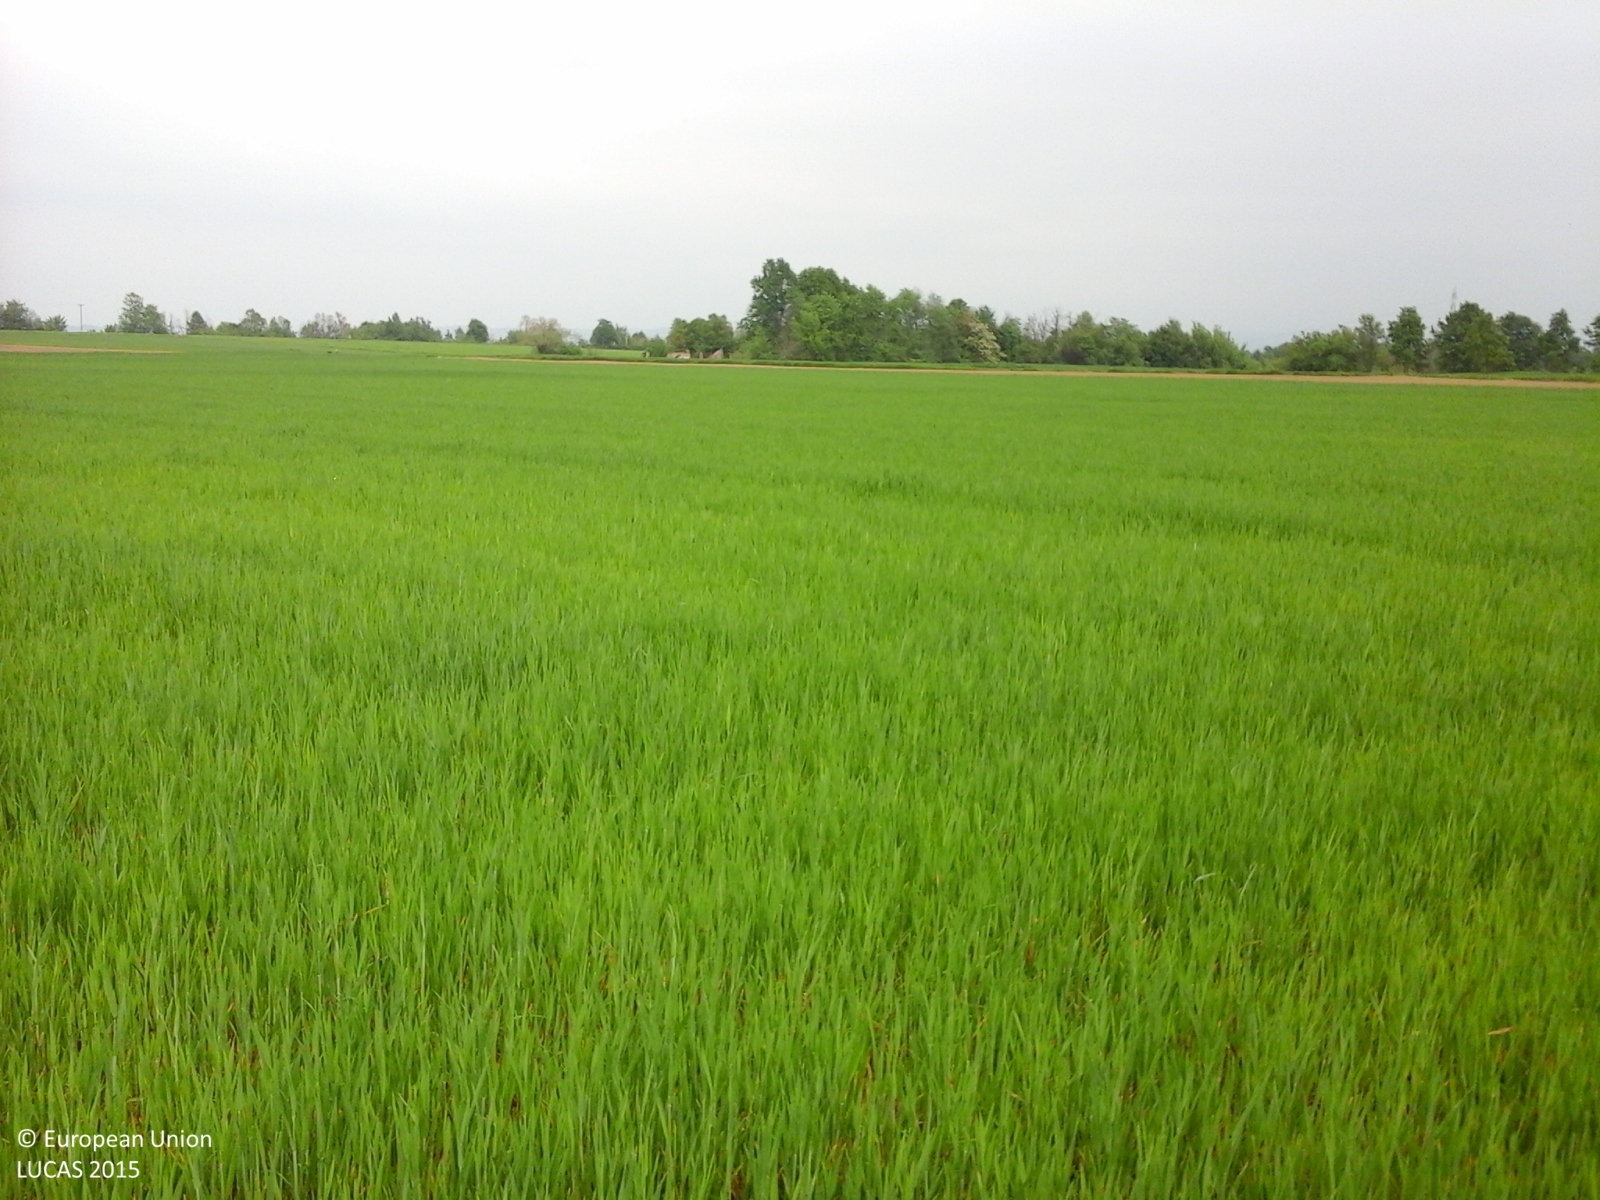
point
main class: Cropland
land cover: Common wheat
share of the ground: > 75 %
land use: Agriculture (excluding fallow land and kitchen gardens)
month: May
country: IT
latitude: 44.5623
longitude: 7.8263
